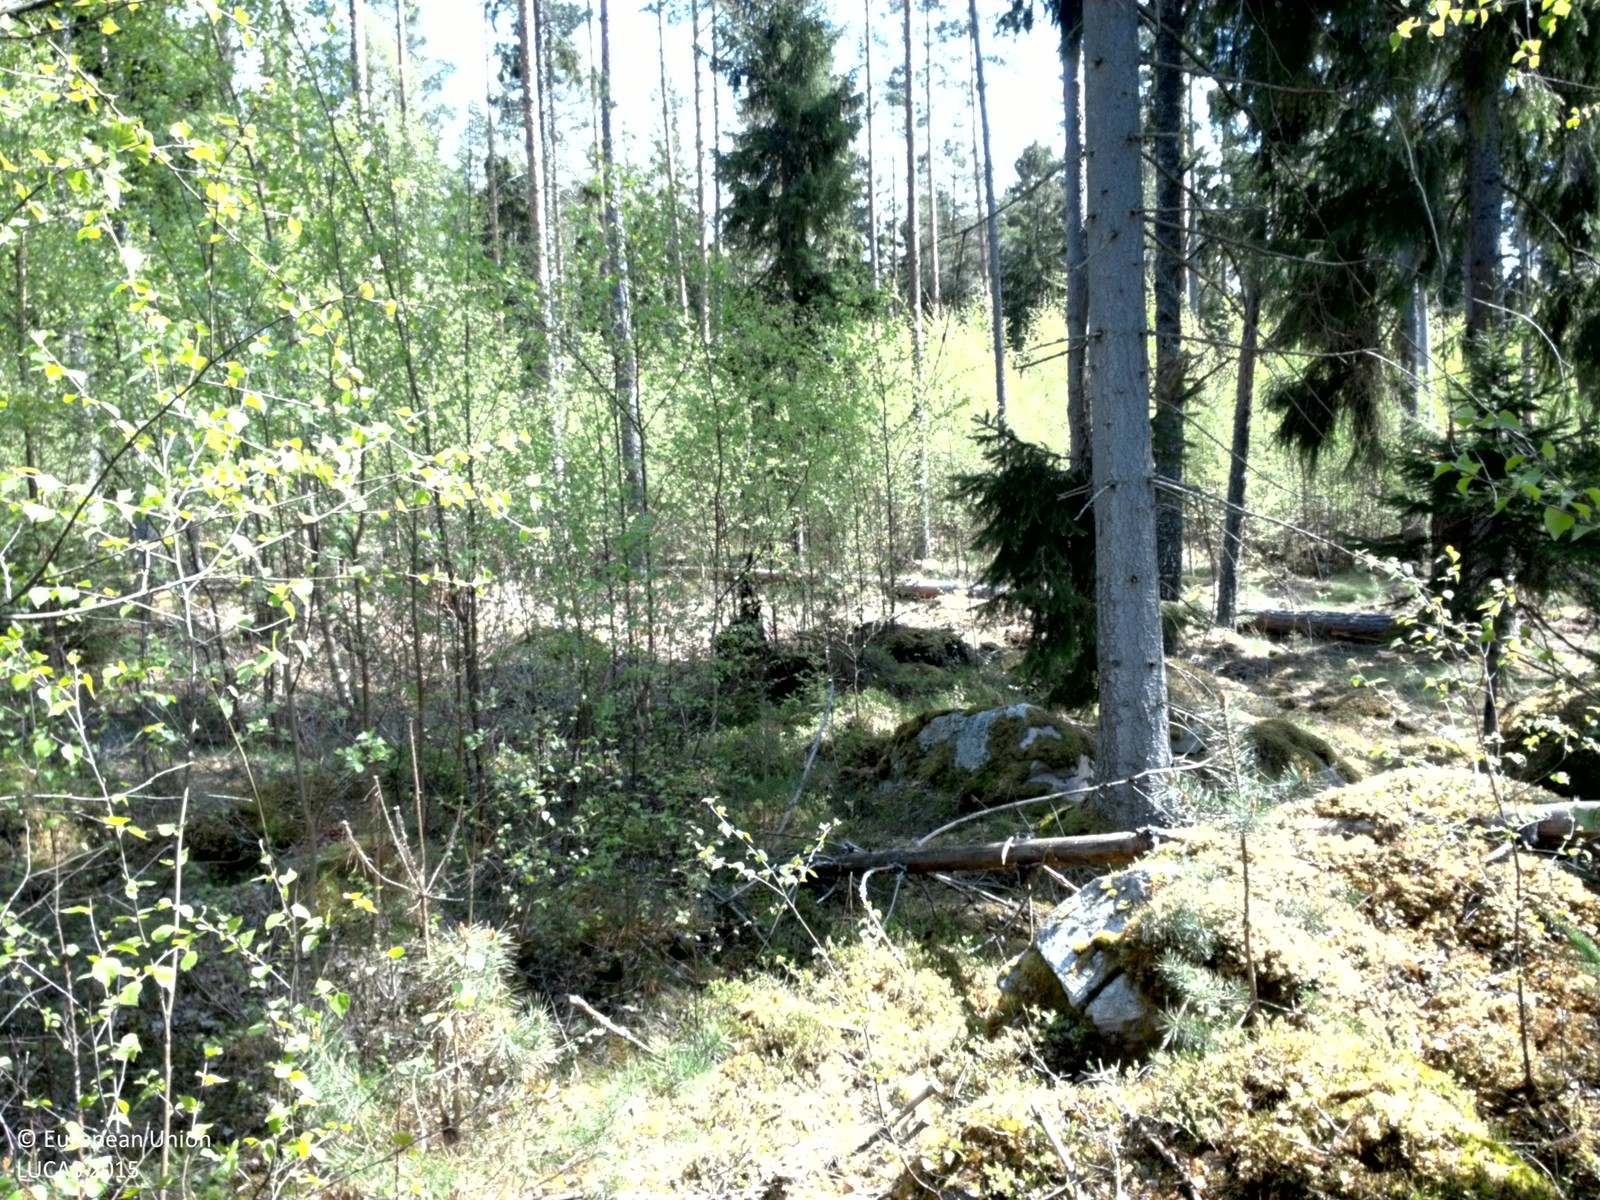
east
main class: Woodland
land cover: Spruce dominated mixed woodland
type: boreal forest
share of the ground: 50 - 75 %
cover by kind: broadleaved forest trees 45 %, coniferous forest trees 25 %, herbaceous plants 15 %, lichens and mosses 15 %
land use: Forestry
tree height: > 5 m
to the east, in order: Spruce dominated mixed woodland; Spruce dominated coniferous woodland; Spruce dominated mixed woodland; Broadleaved woodland
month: May
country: SE
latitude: 56.6728
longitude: 14.8445
